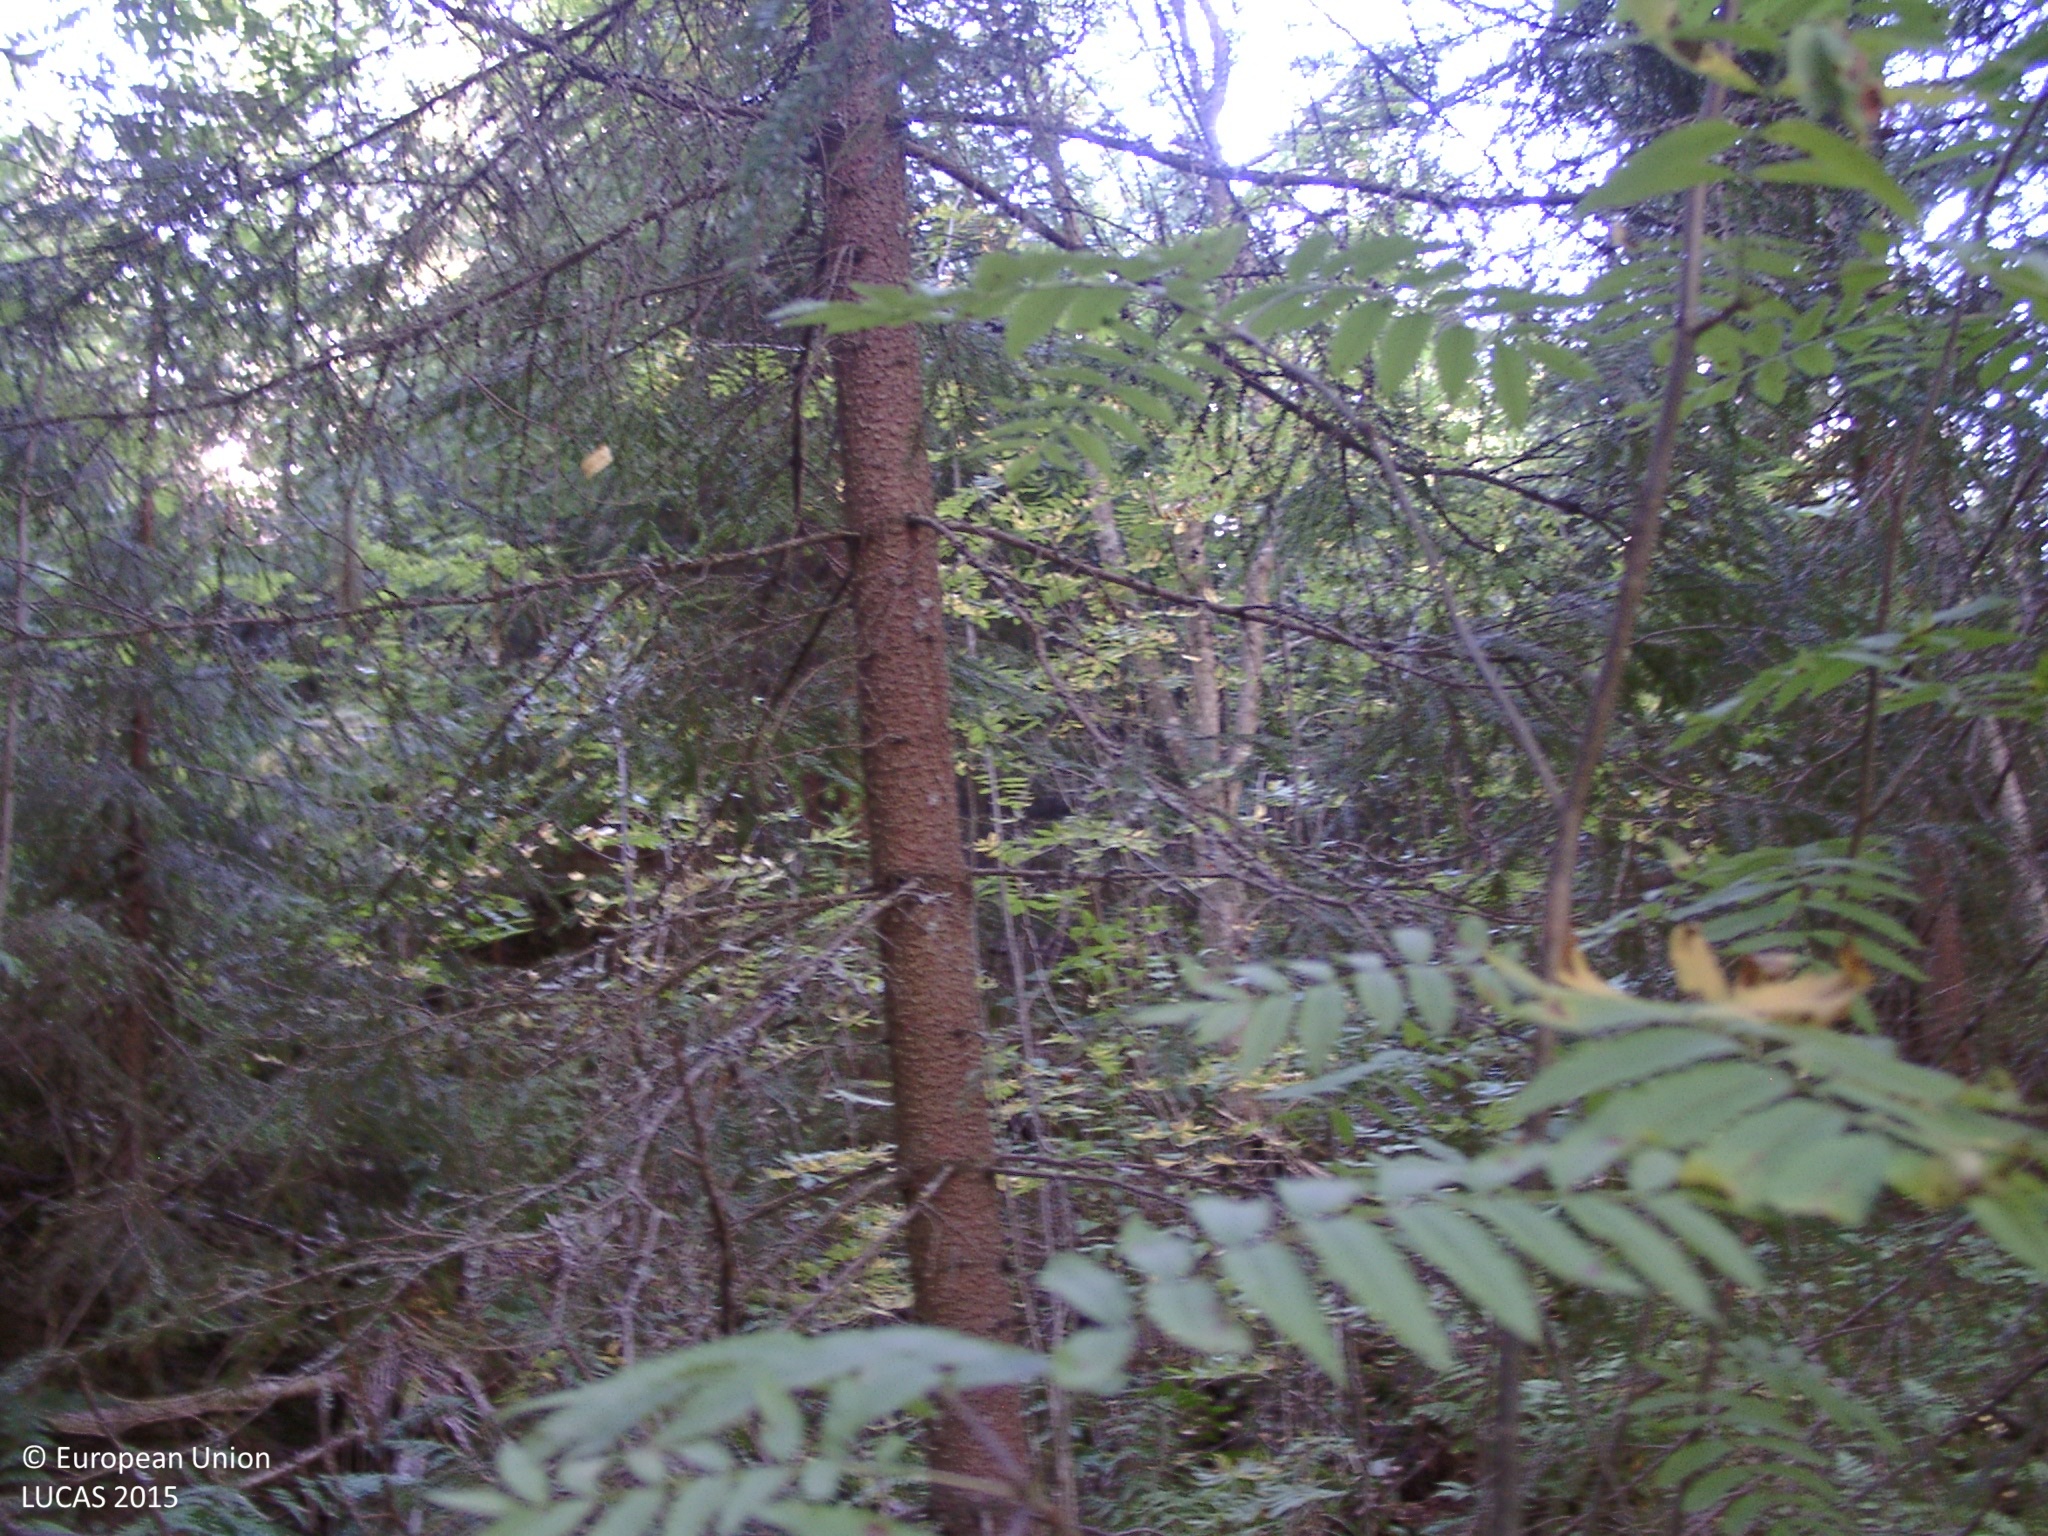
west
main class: Woodland
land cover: Spruce dominated mixed woodland
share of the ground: > 75 %
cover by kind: coniferous forest trees 60 %, broadleaved forest trees 20 %, shrubs 10 %, herbaceous plants 5 %, lichens and mosses 5 %
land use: Forestry
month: August
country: FI
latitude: 62.3347
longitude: 25.6980
